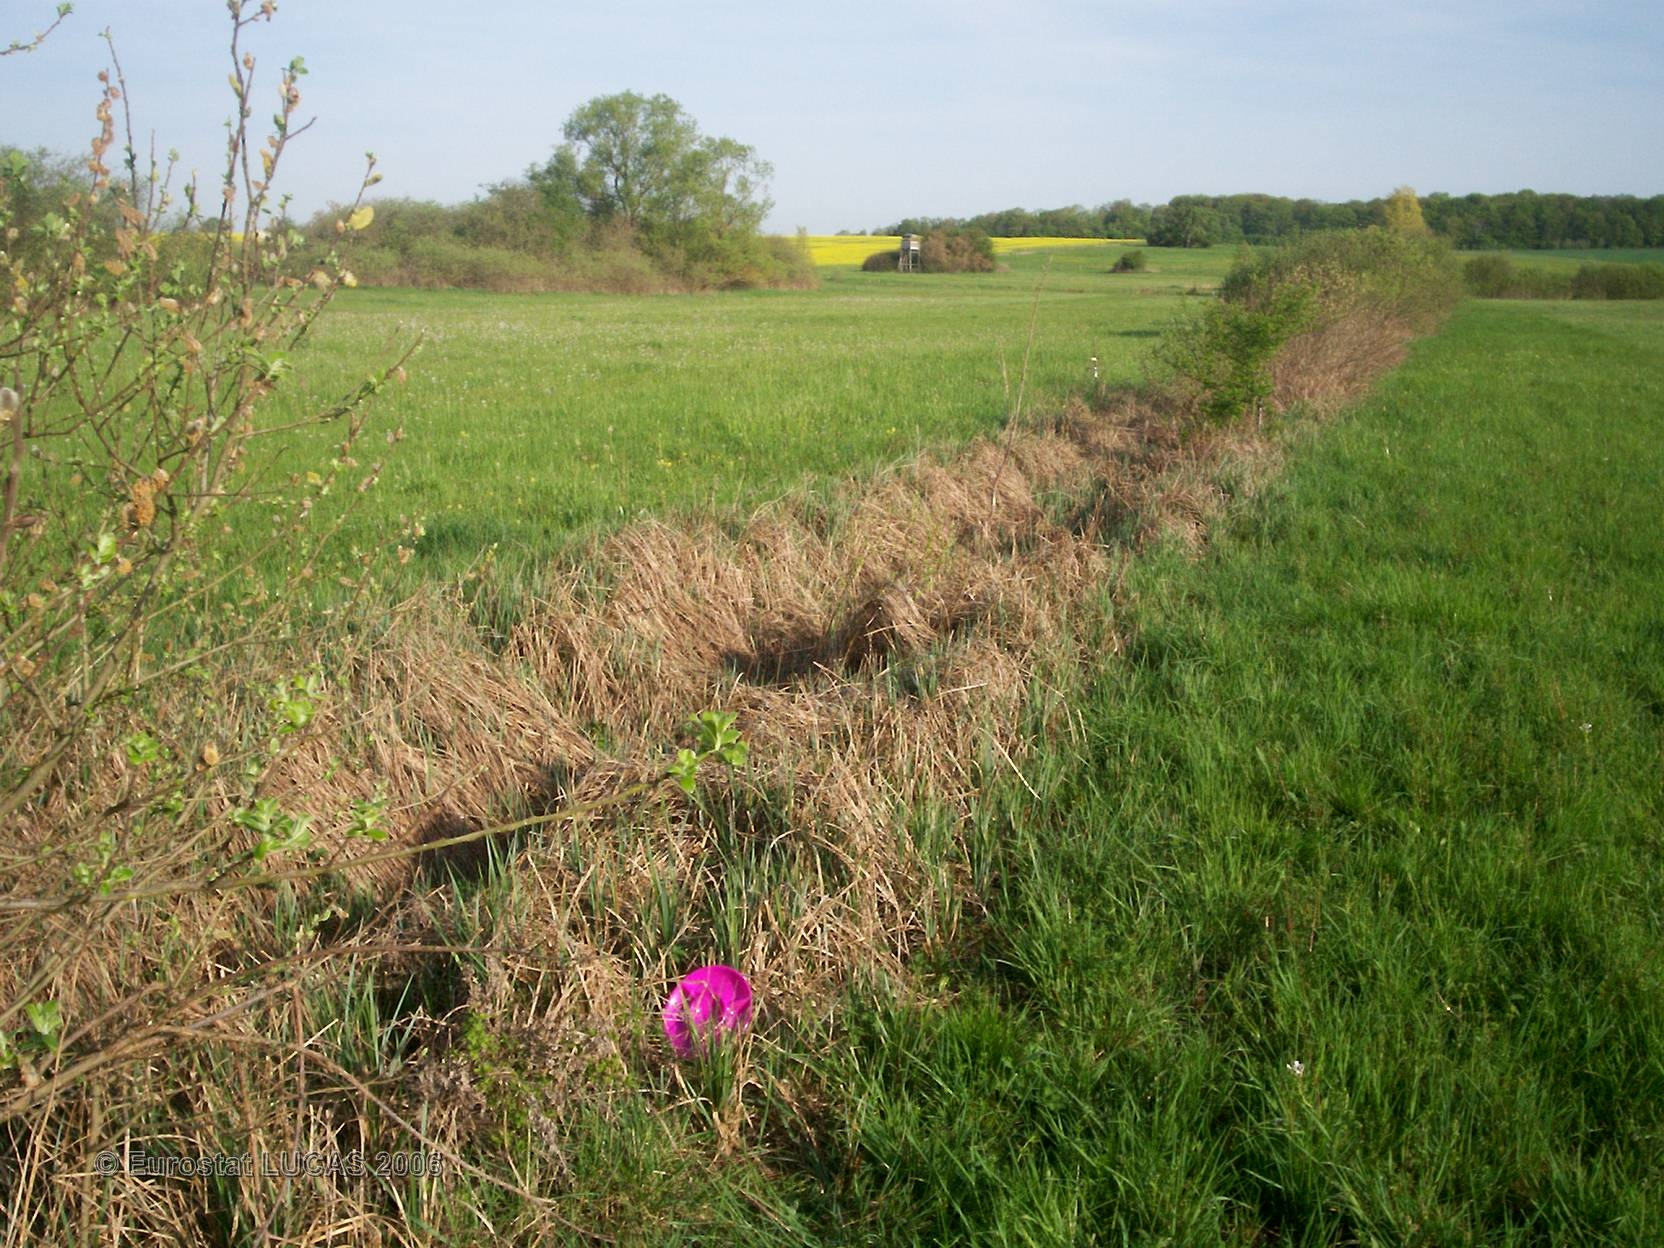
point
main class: Grassland
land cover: Grassland without tree/shrub cover
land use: Agriculture (excluding fallow land and kitchen gardens)
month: May
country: FR
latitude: 48.9909
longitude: 6.9255
